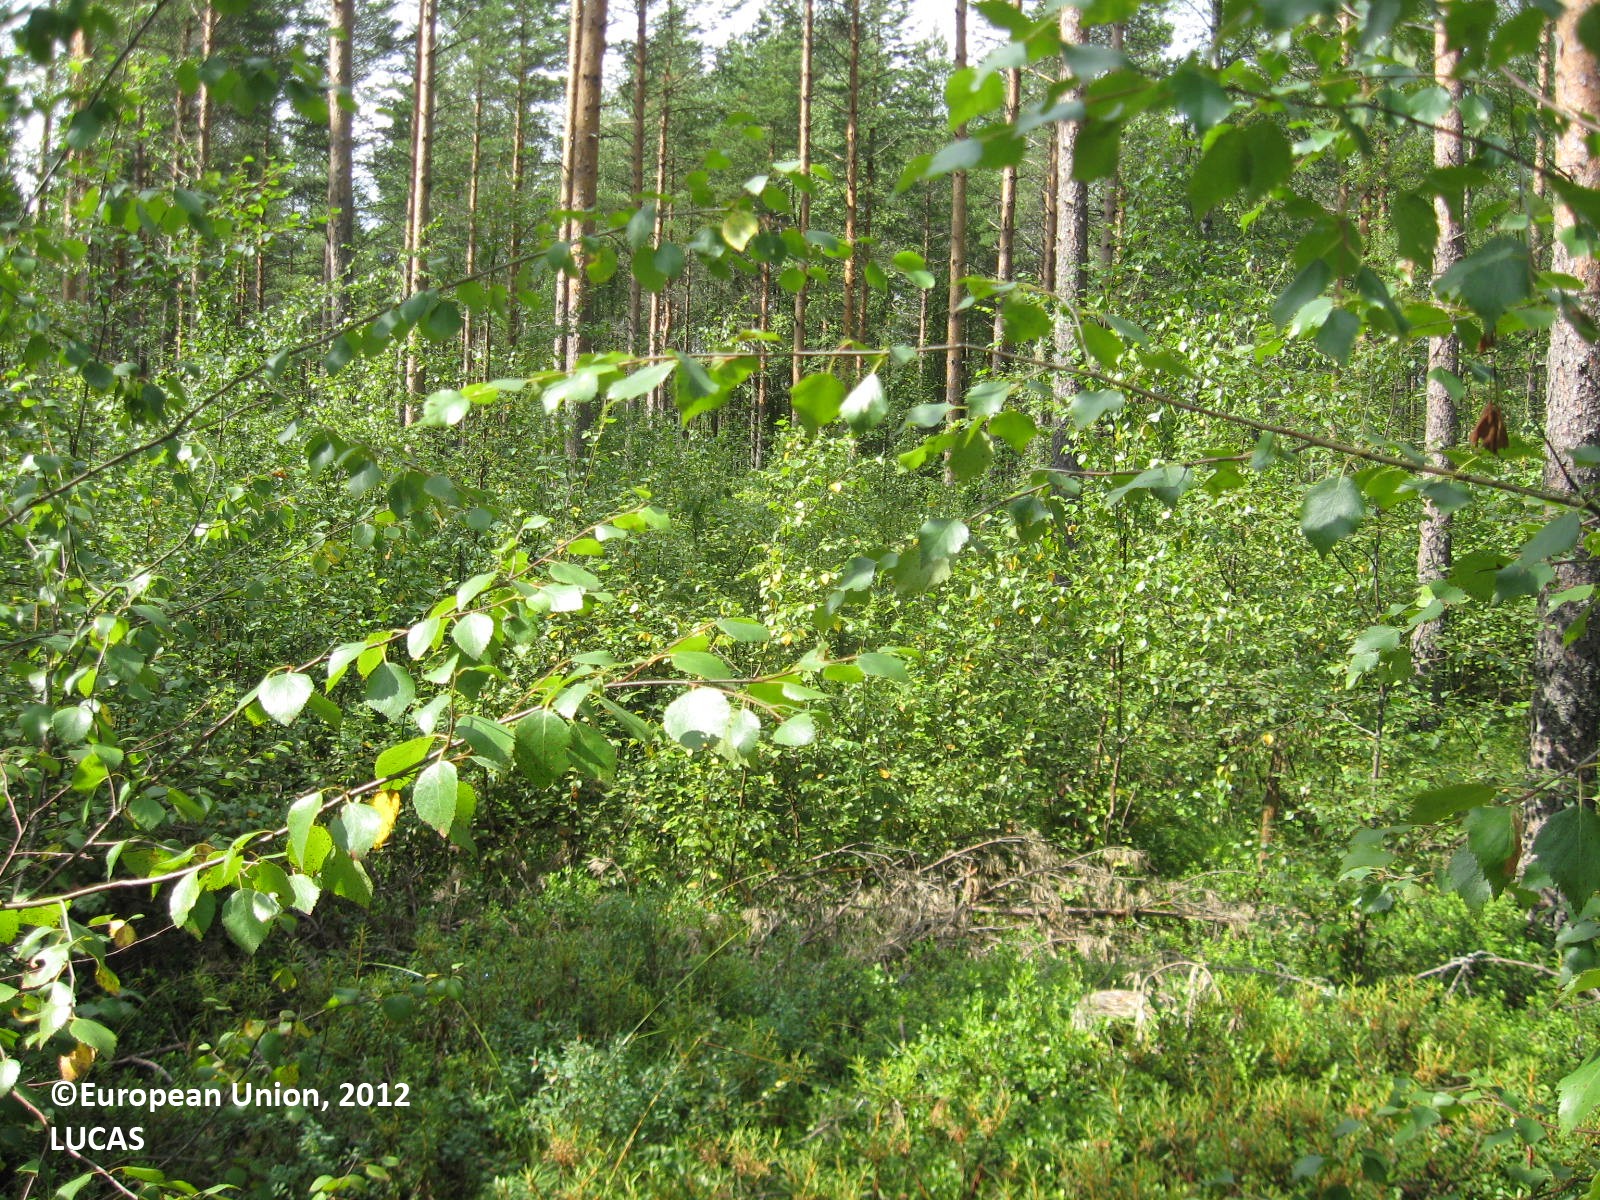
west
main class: Woodland
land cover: Pine dominated coniferous woodland
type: boreal forest
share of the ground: 50 - 75 %
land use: Forestry
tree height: > 5 m
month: July
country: FI
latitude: 62.0741
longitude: 22.6751
